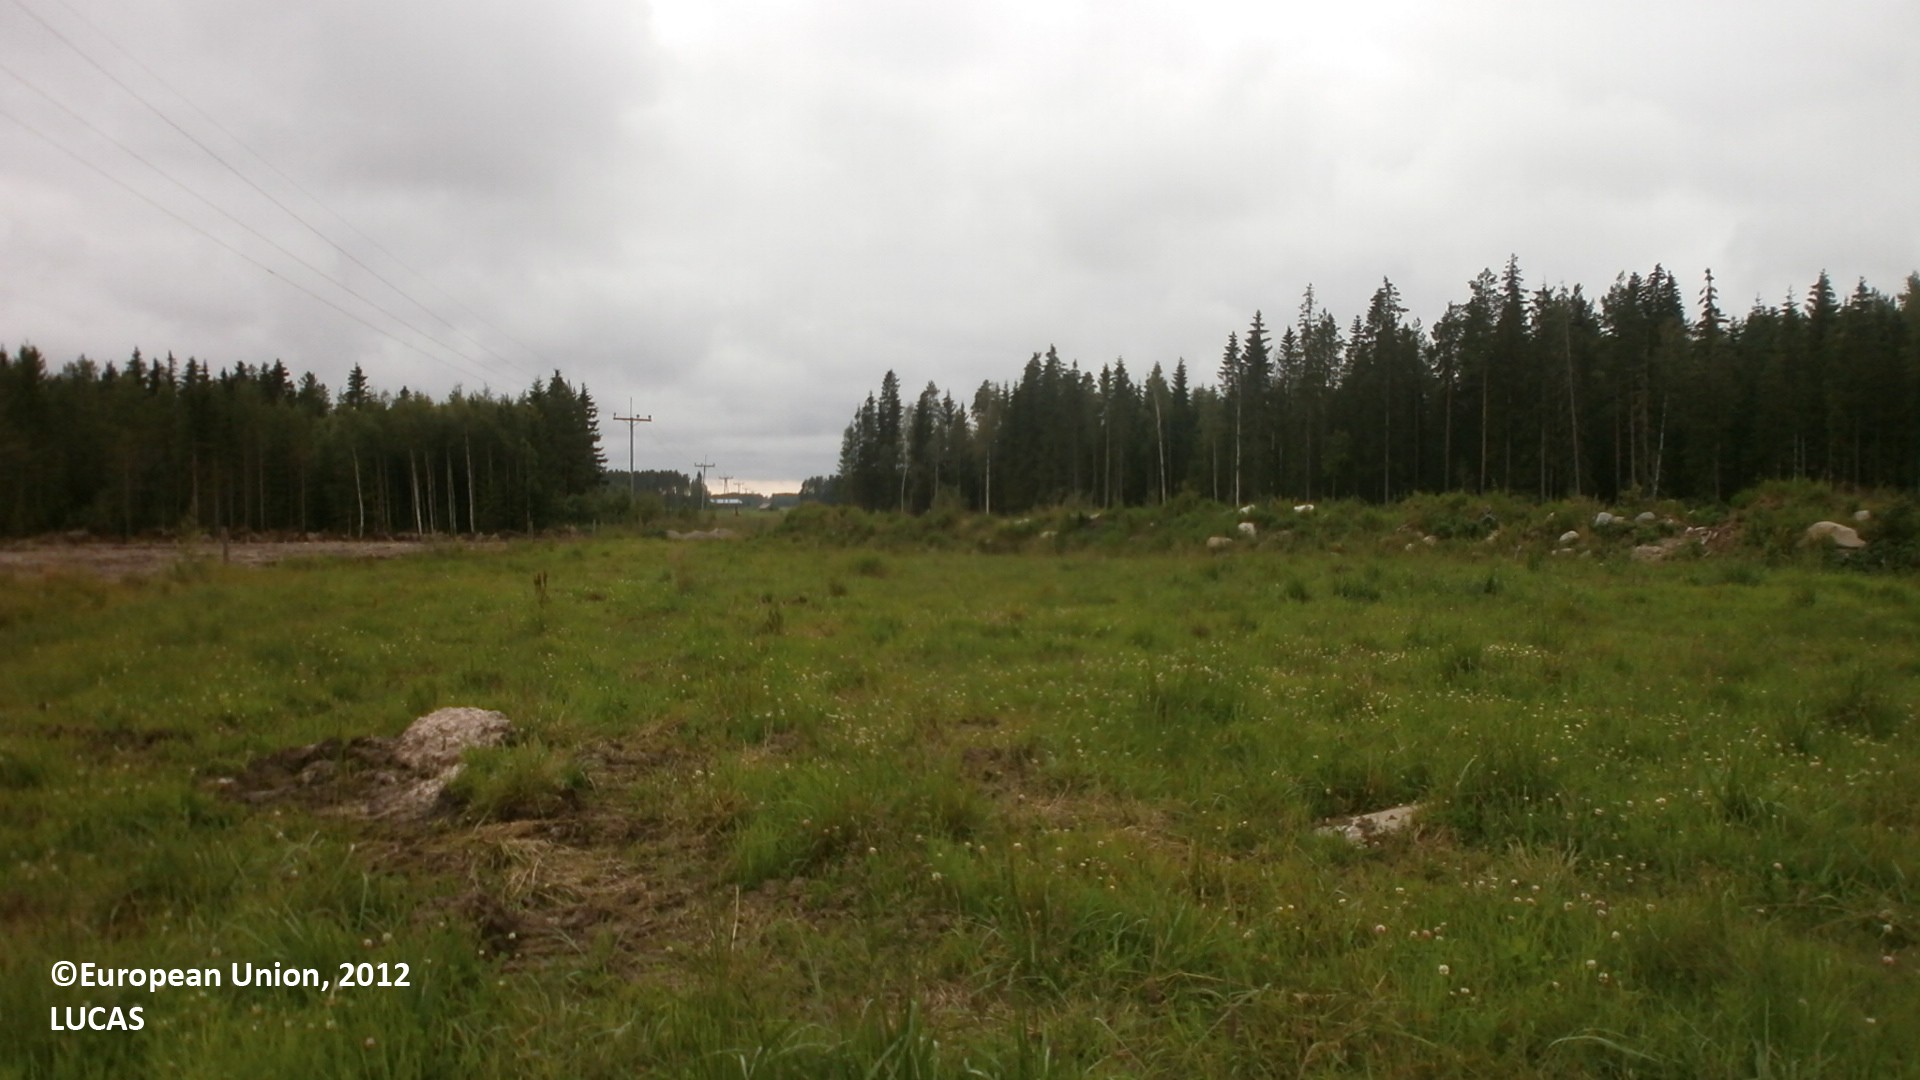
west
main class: Grassland
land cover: Grassland without tree/shrub cover
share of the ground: 50 - 75 %
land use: Agriculture (excluding fallow land and kitchen gardens)
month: July
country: FI
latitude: 64.2070
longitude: 24.0923
